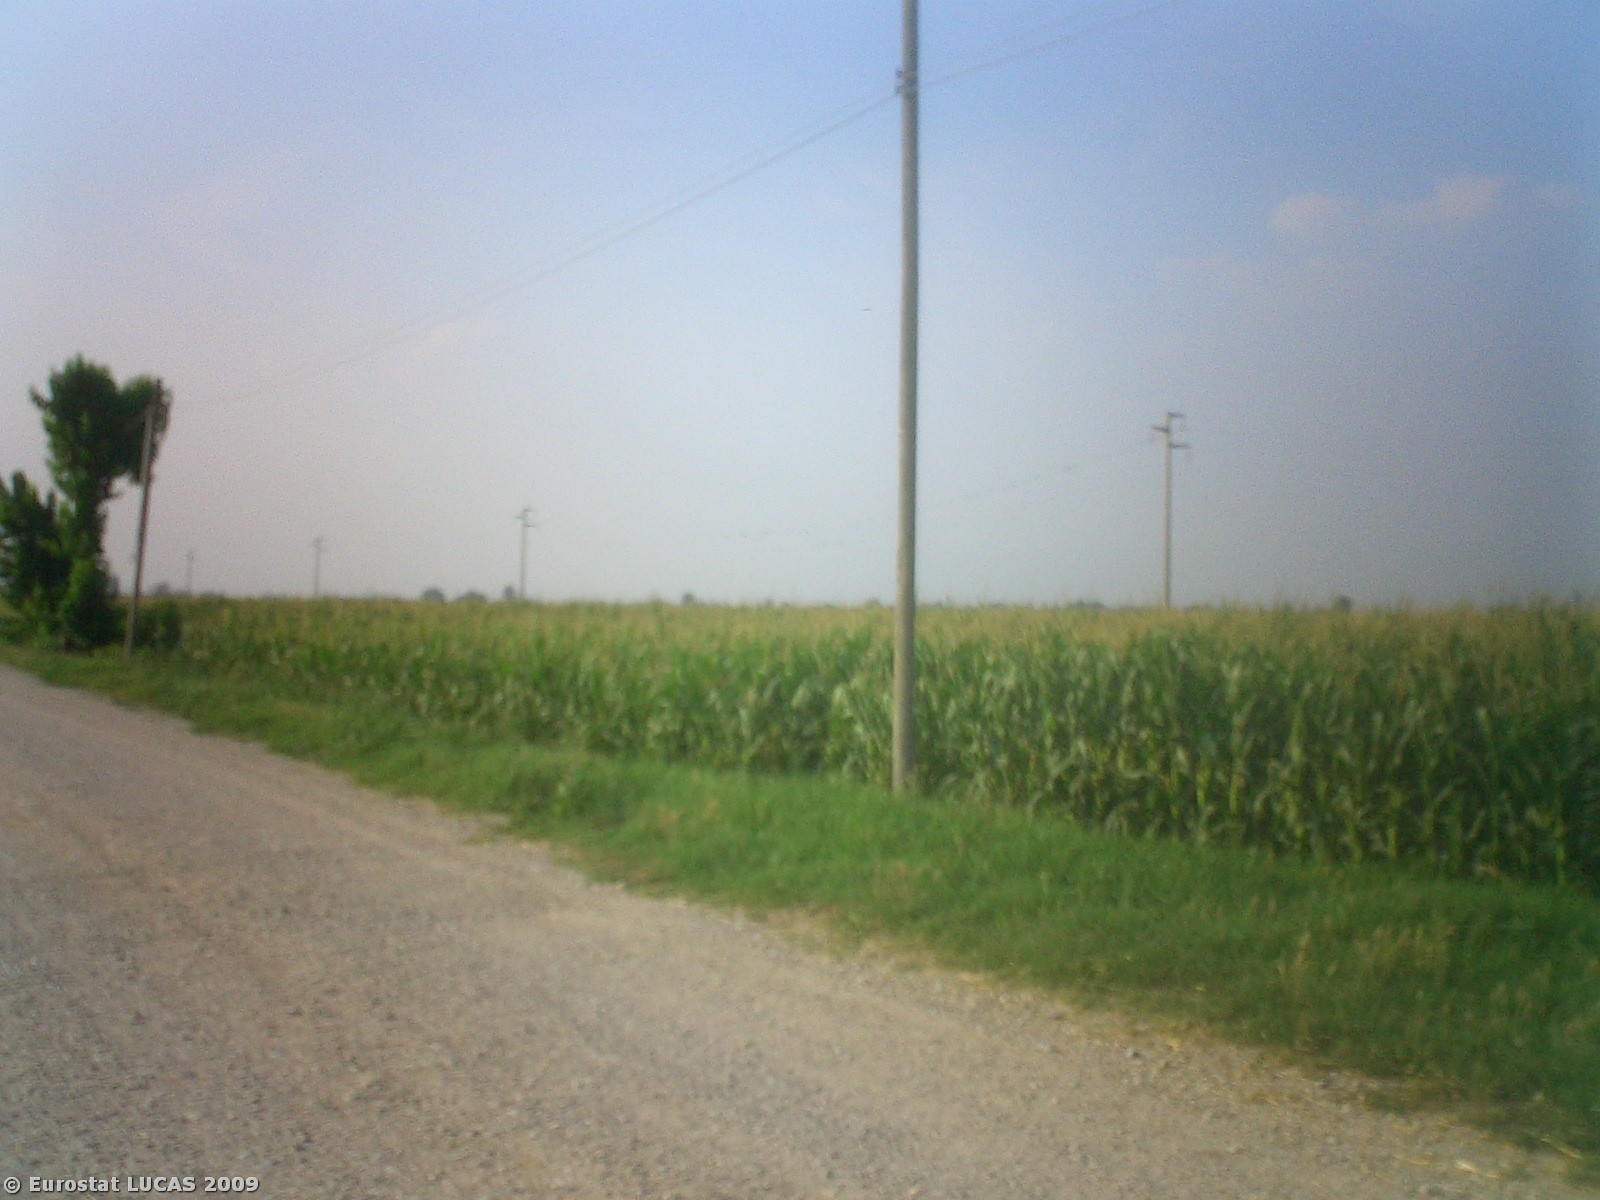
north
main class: Cropland
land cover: Common wheat
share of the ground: > 75 %
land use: Agriculture (excluding fallow land and kitchen gardens)
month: July
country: IT
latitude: 44.6223
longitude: 11.8740
